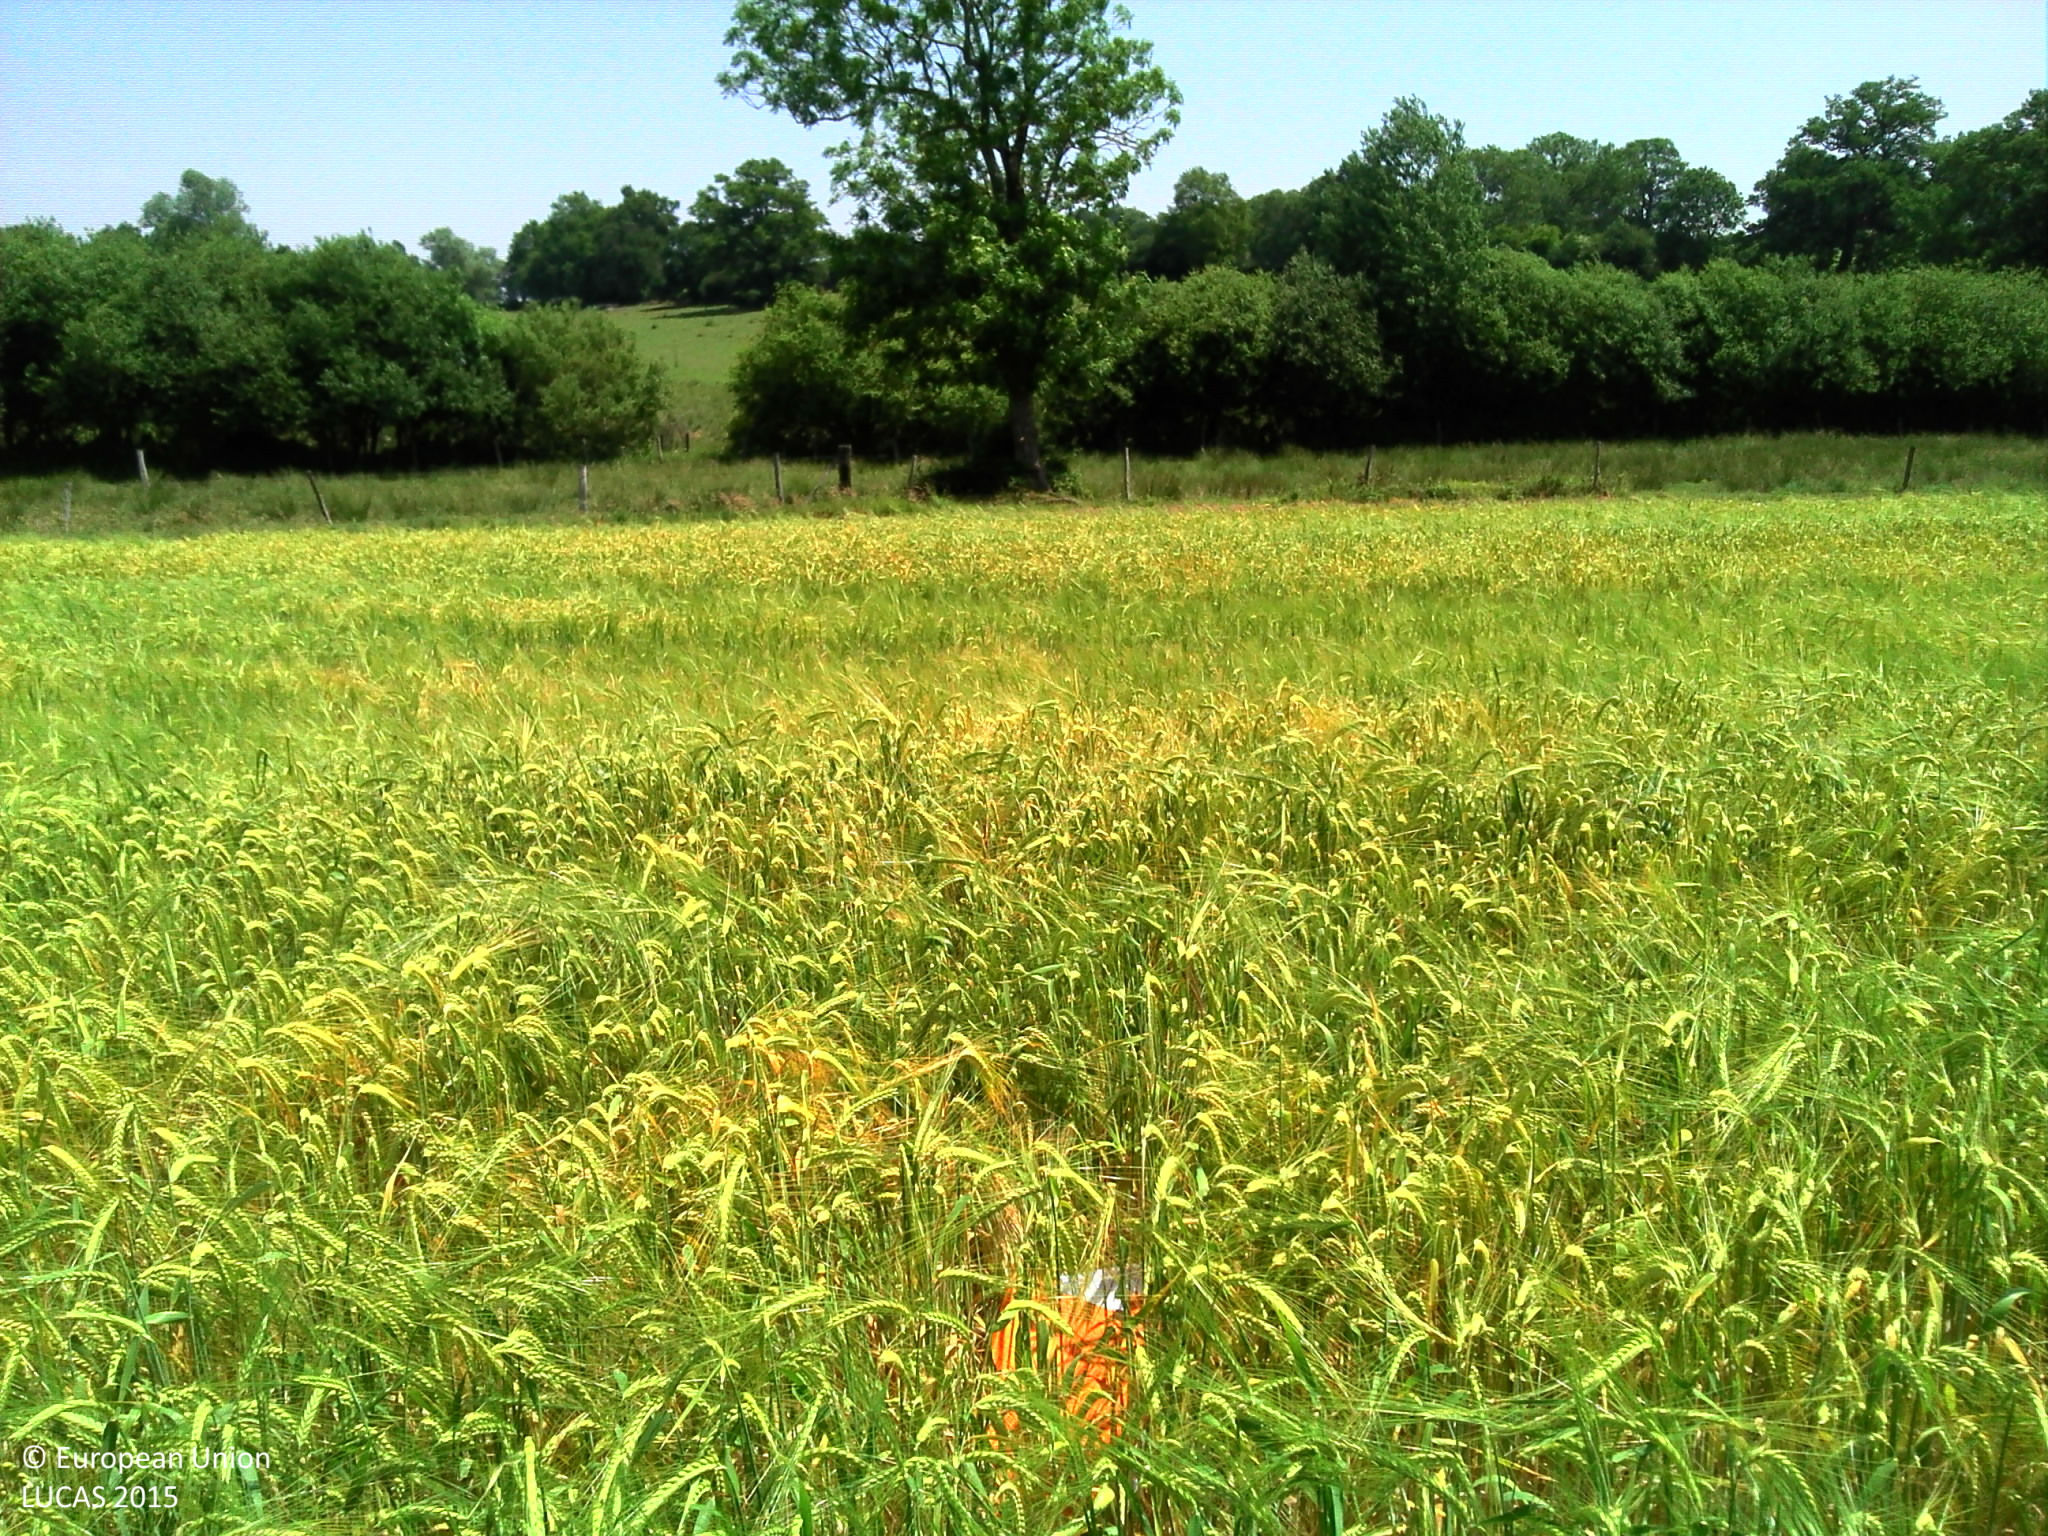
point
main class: Cropland
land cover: Barley
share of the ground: > 75 %
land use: Agriculture (excluding fallow land and kitchen gardens)
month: June
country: FR
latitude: 46.3597
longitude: 3.0444
